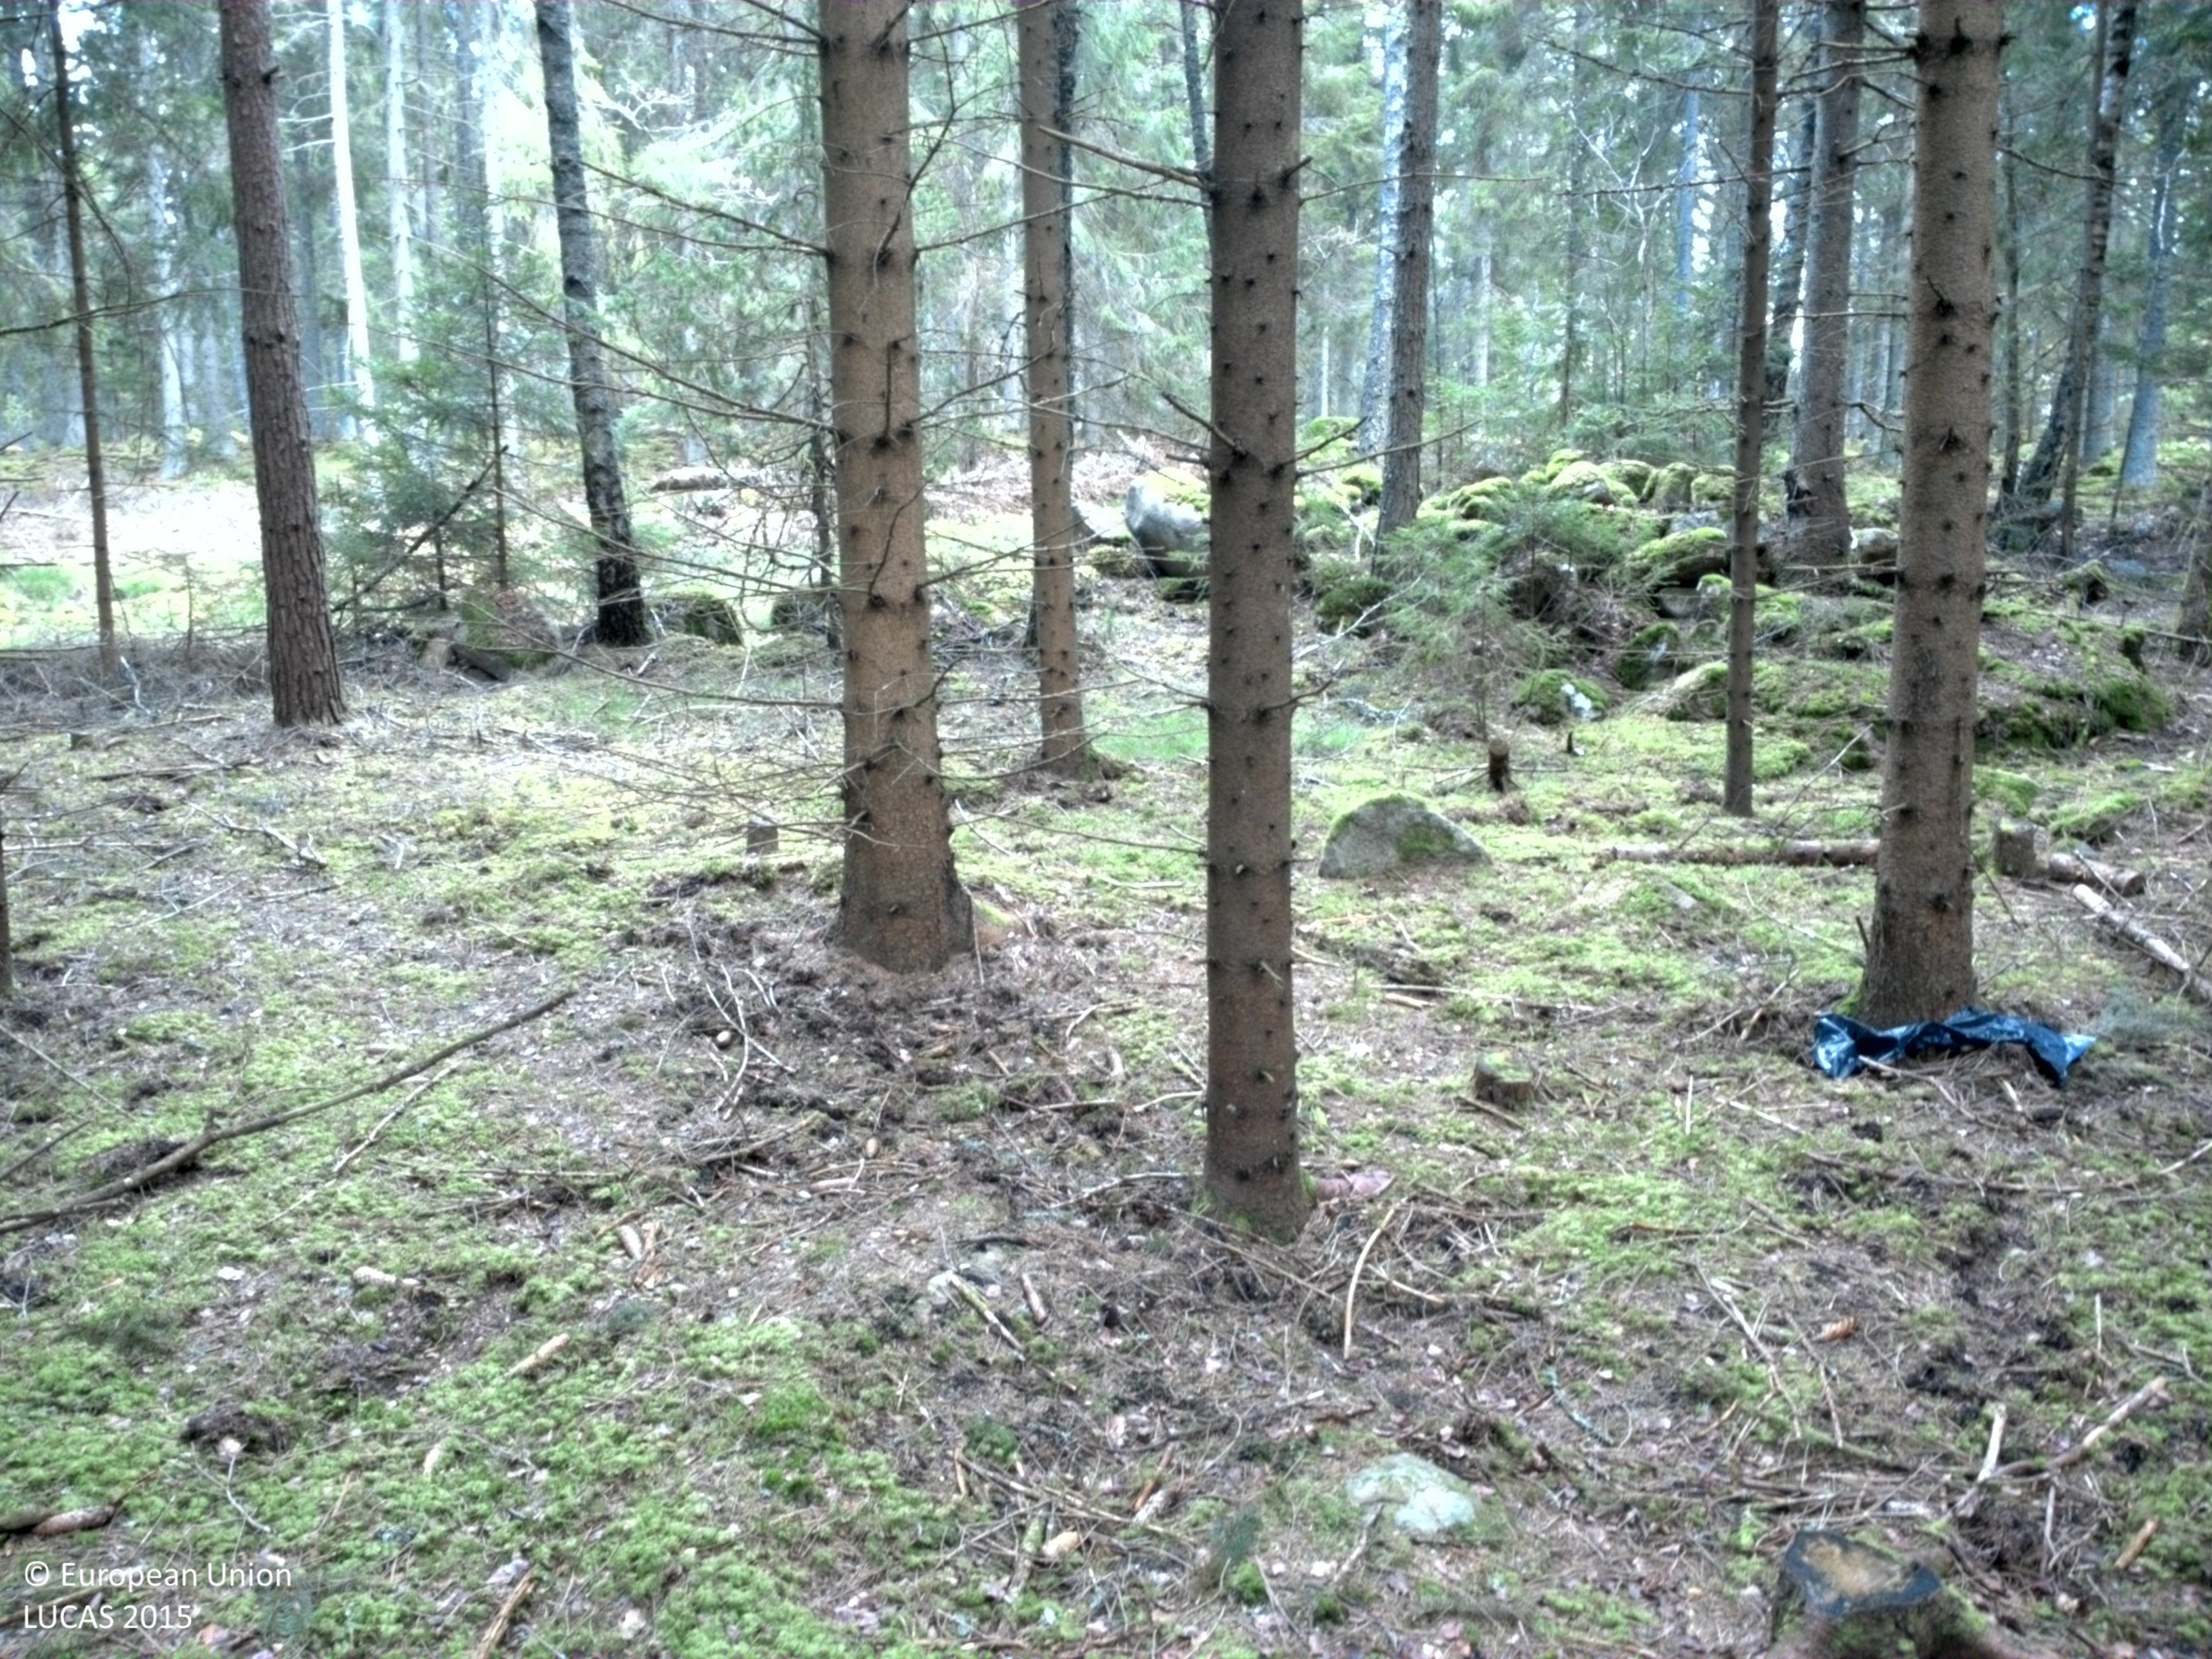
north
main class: Woodland
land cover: Spruce dominated coniferous woodland
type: boreal forest
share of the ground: > 75 %
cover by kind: coniferous forest trees 95 %, broadleaved forest trees 5 %
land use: Forestry
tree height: > 5 m
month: May
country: SE
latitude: 56.4884
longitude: 15.4069
